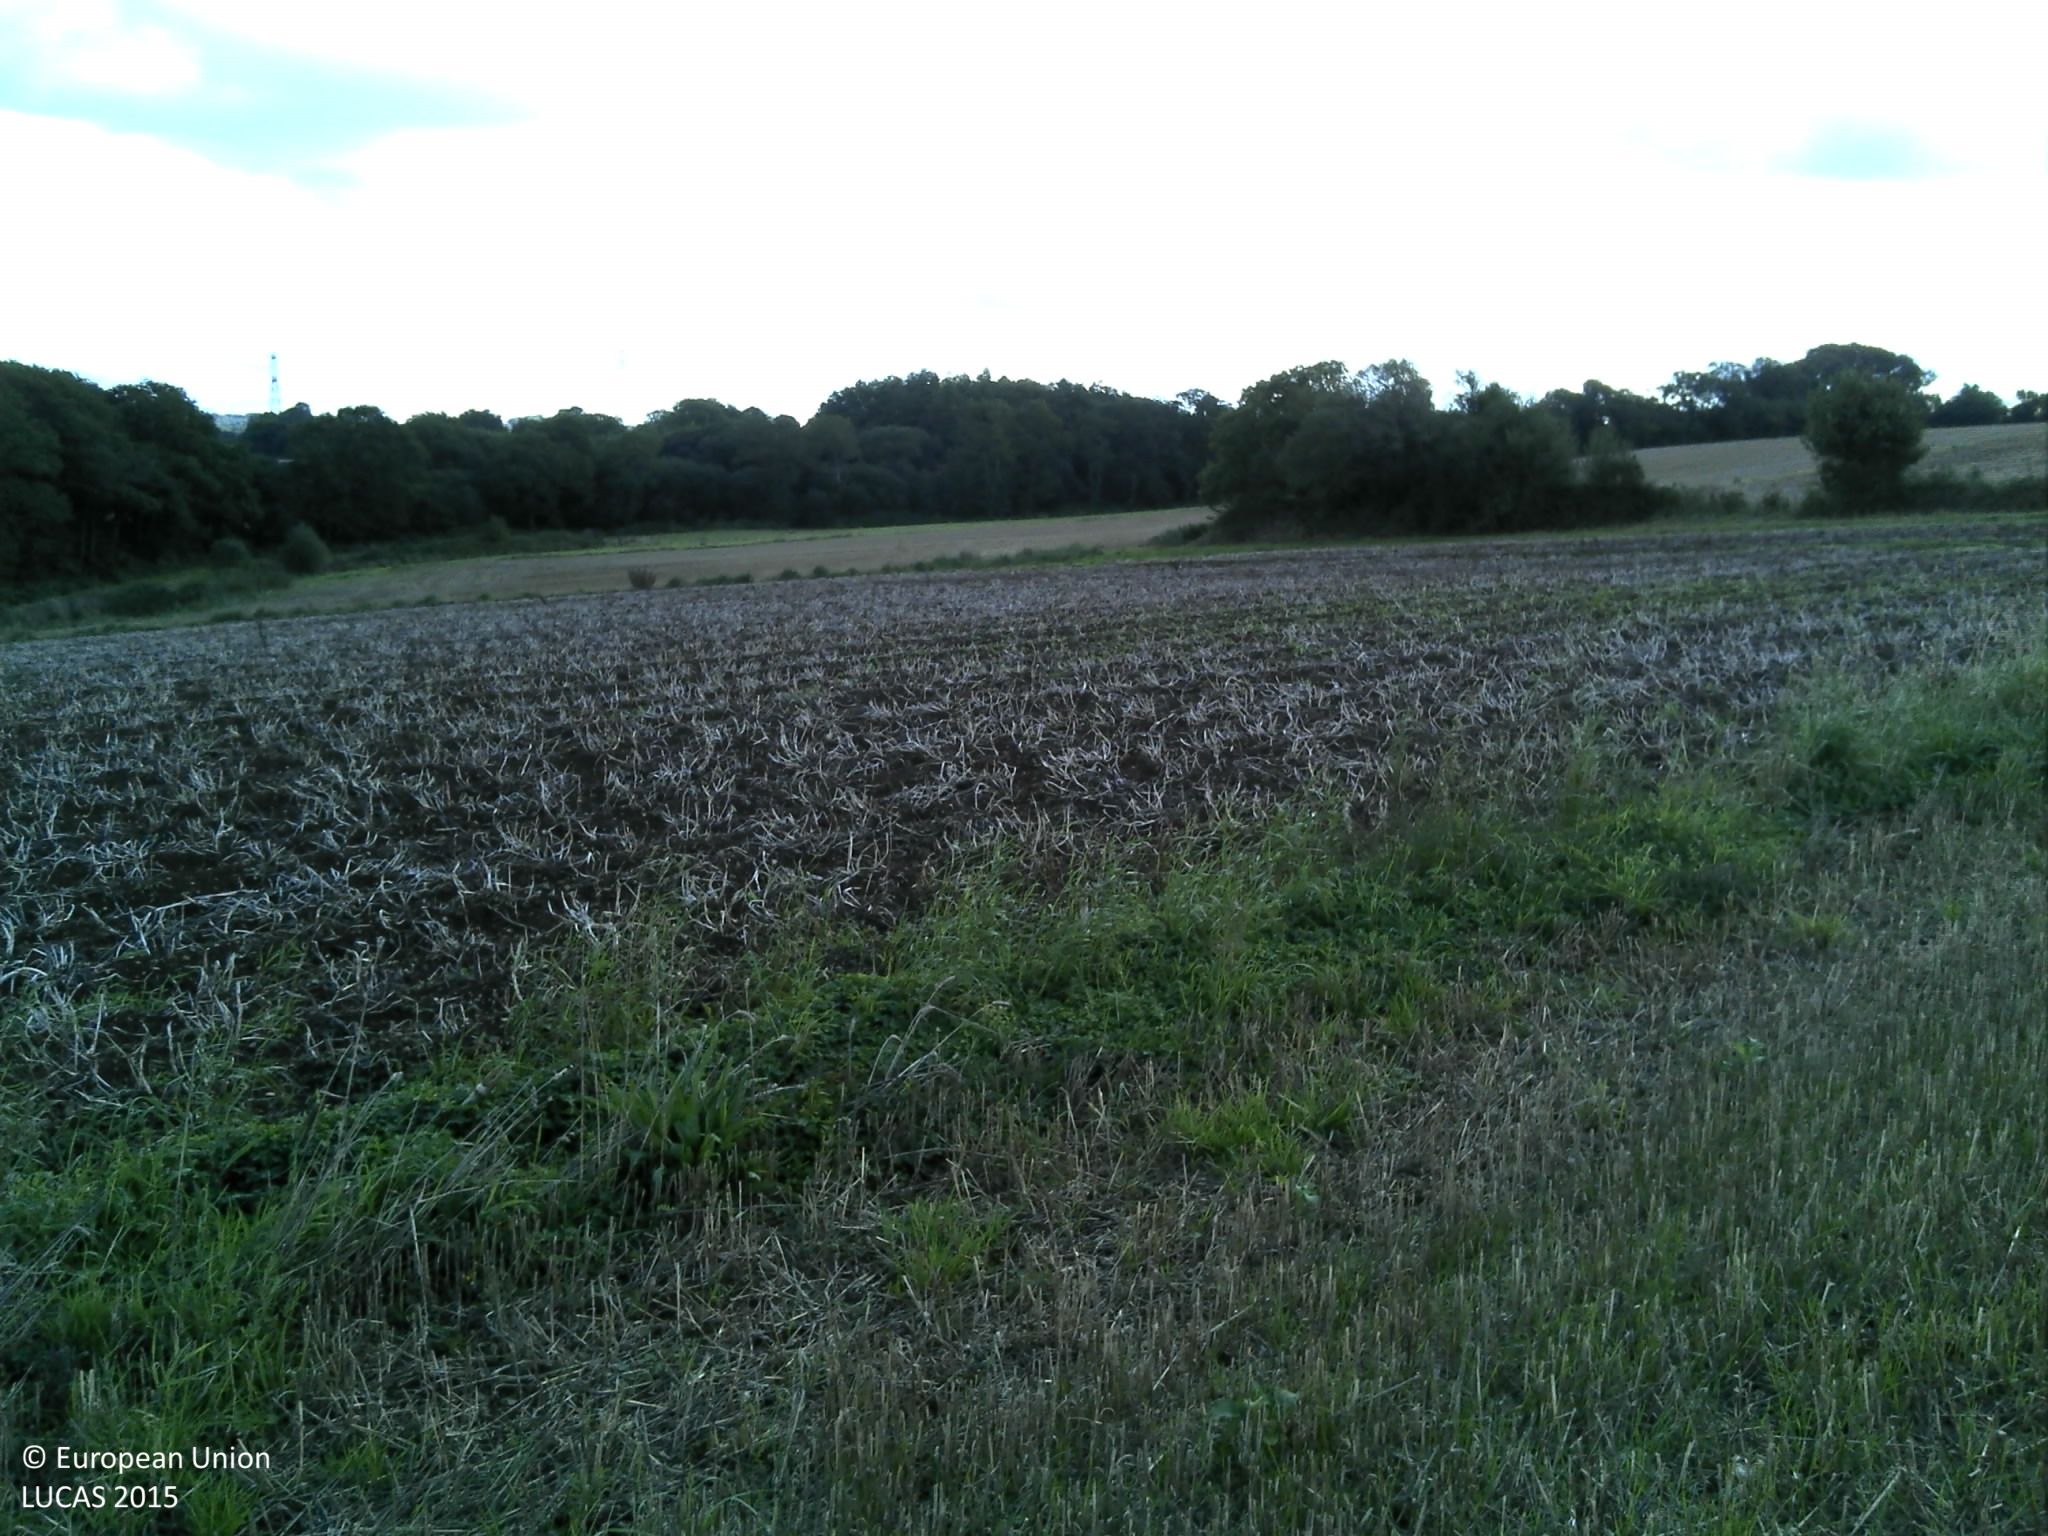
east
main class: Cropland
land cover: Durum wheat
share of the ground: > 75 %
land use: Agriculture (excluding fallow land and kitchen gardens)
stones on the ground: < 10 %
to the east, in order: Durum wheat; Grass margins; Potatoes; Grass margins; Ditches and canals; Other bare soil; Grassland without tree/shrub cover; Rivers and streams; Broadleaved woodland
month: September
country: FR
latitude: 48.3620
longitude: -4.1690
